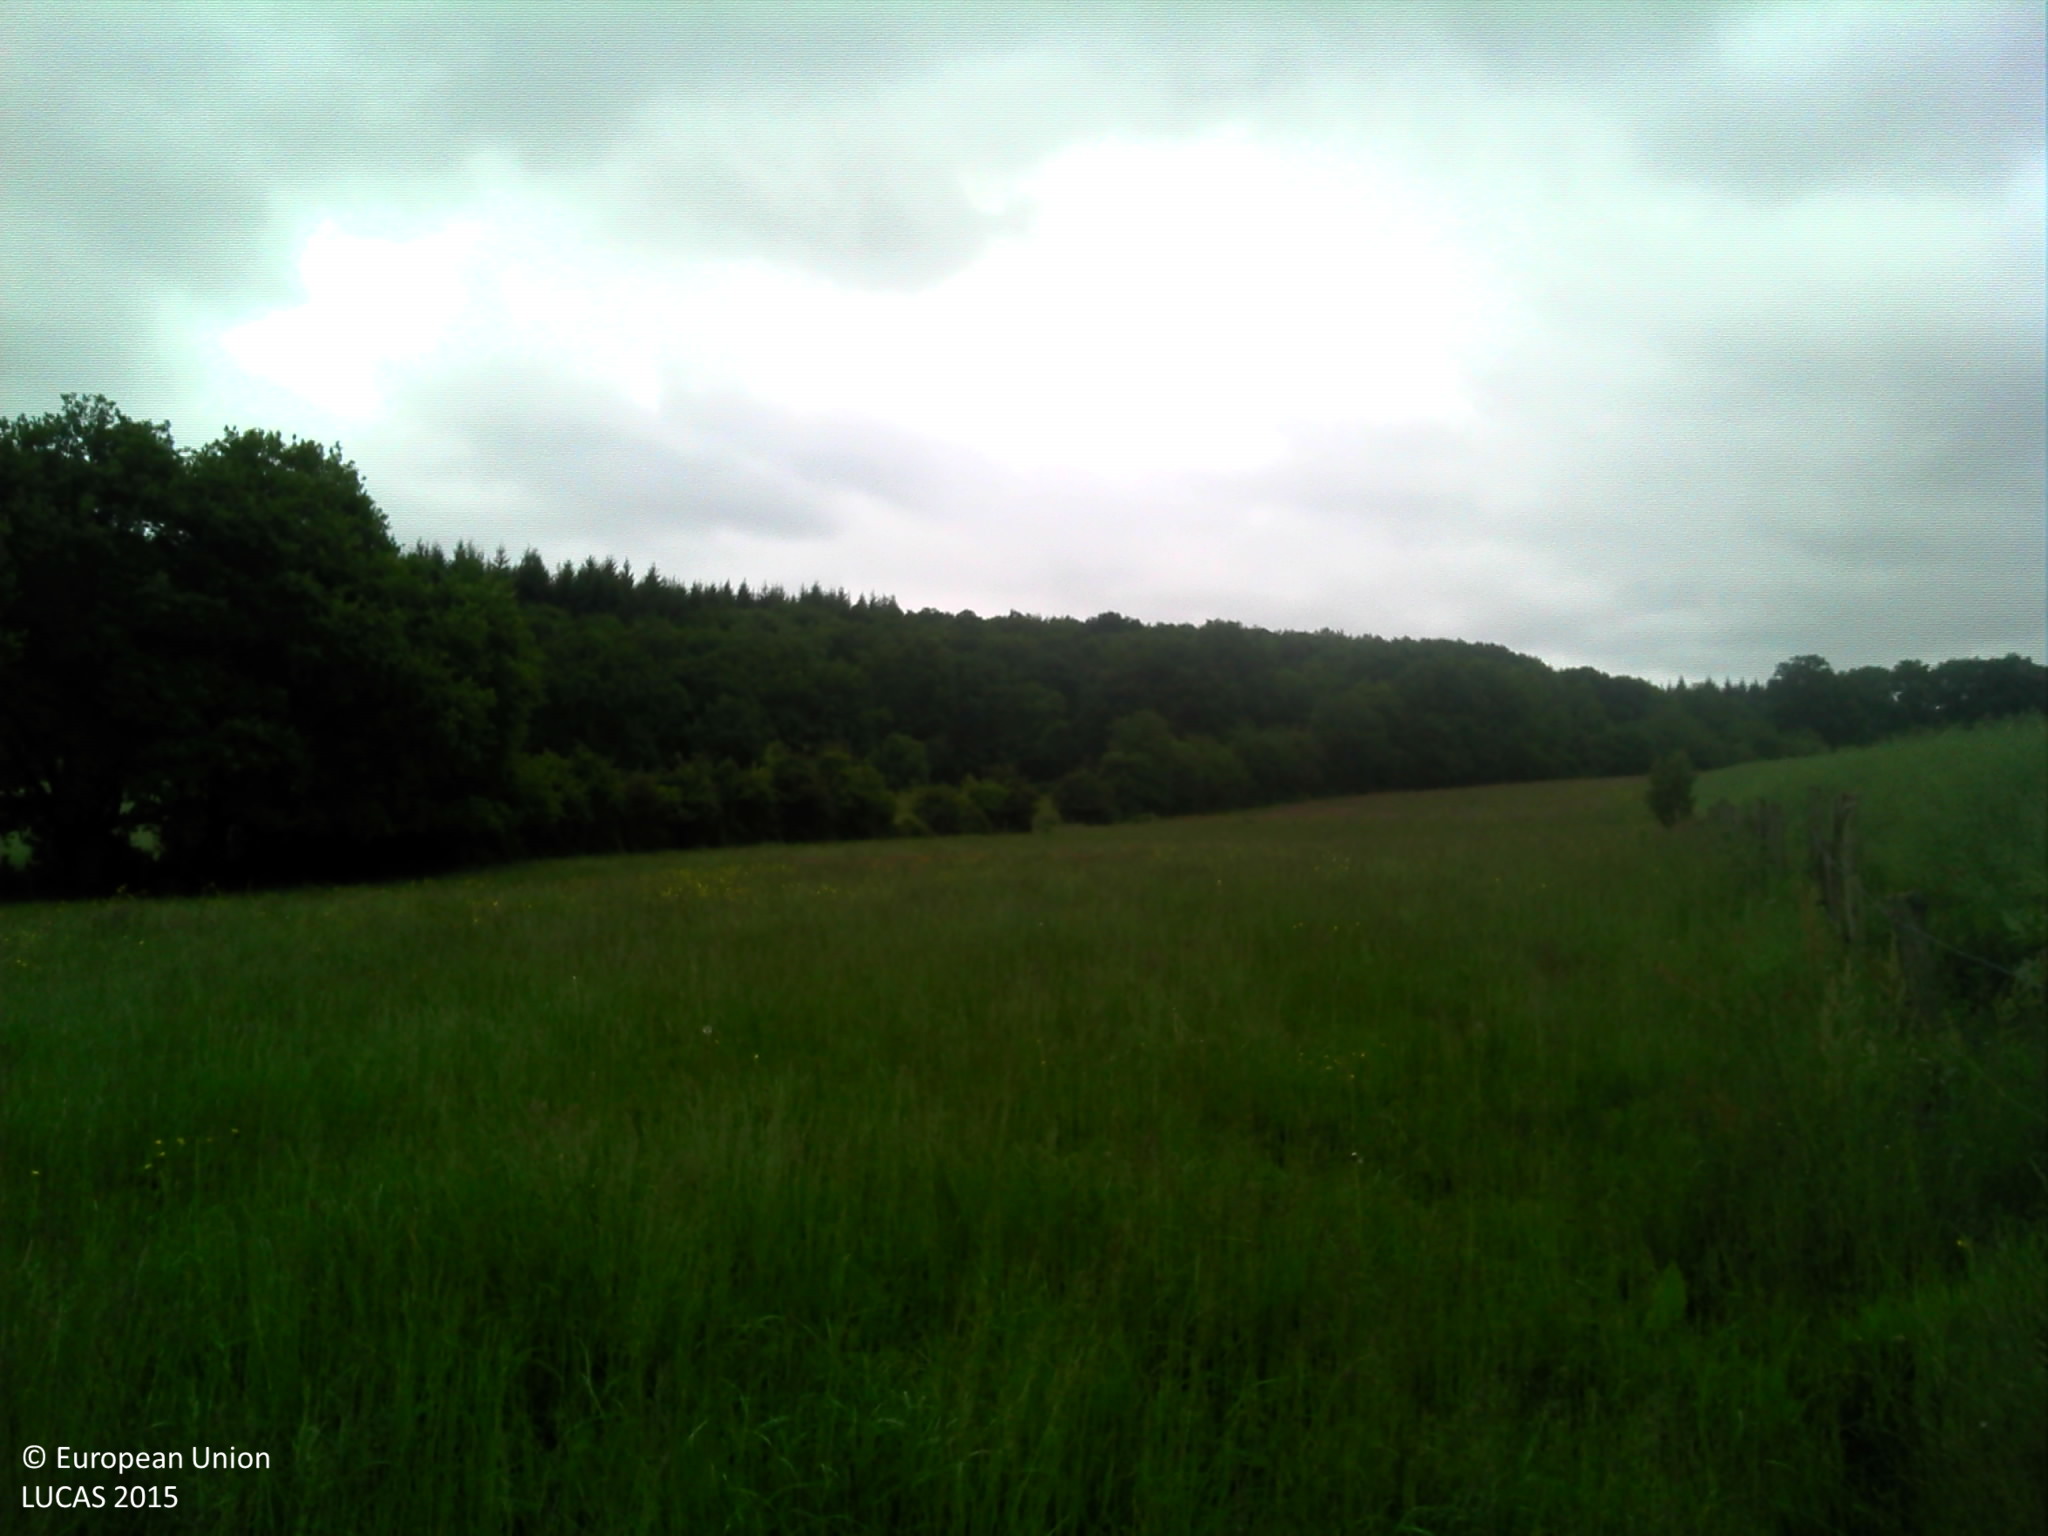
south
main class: Cropland
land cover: Rape and turnip rape
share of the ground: > 75 %
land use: Agriculture (excluding fallow land and kitchen gardens)
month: May
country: FR
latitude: 48.2263
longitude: -0.1397
